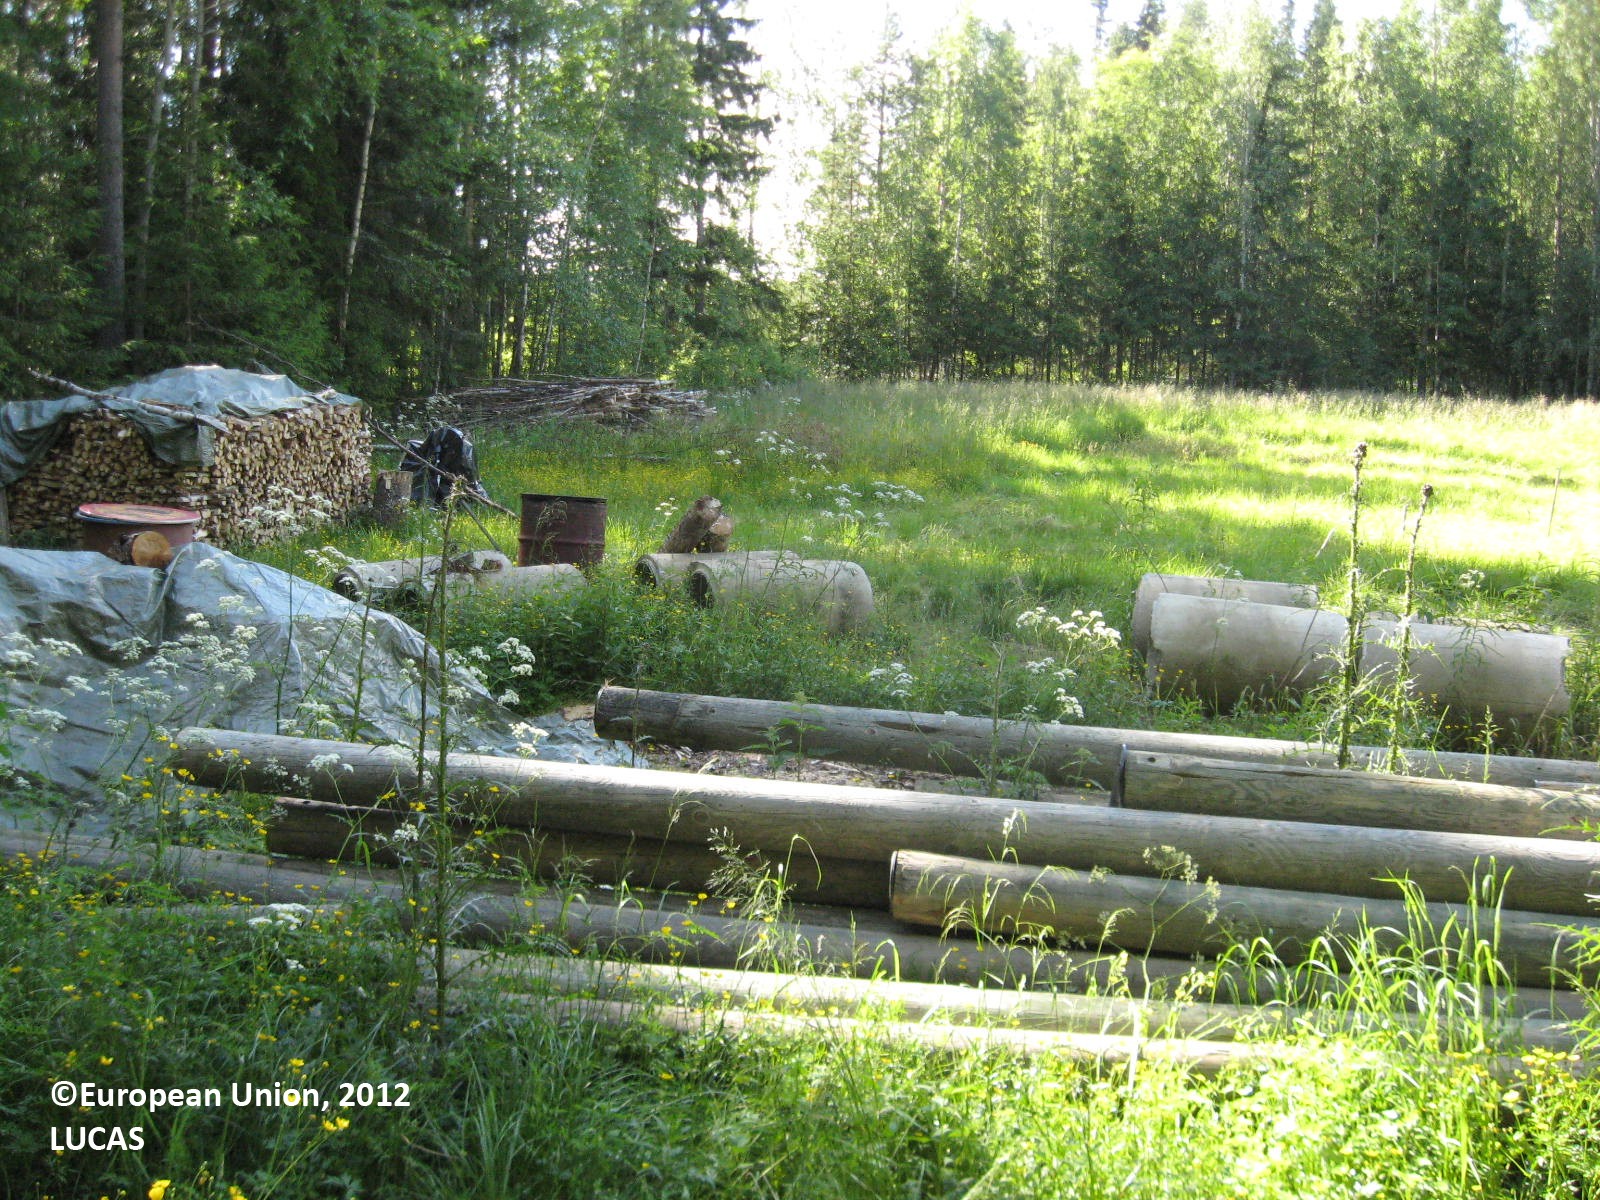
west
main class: Woodland
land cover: Pine dominated mixed woodland
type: boreal forest
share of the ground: > 75 %
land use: Forestry
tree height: > 5 m
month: July
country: FI
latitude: 62.5932
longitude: 22.8144
